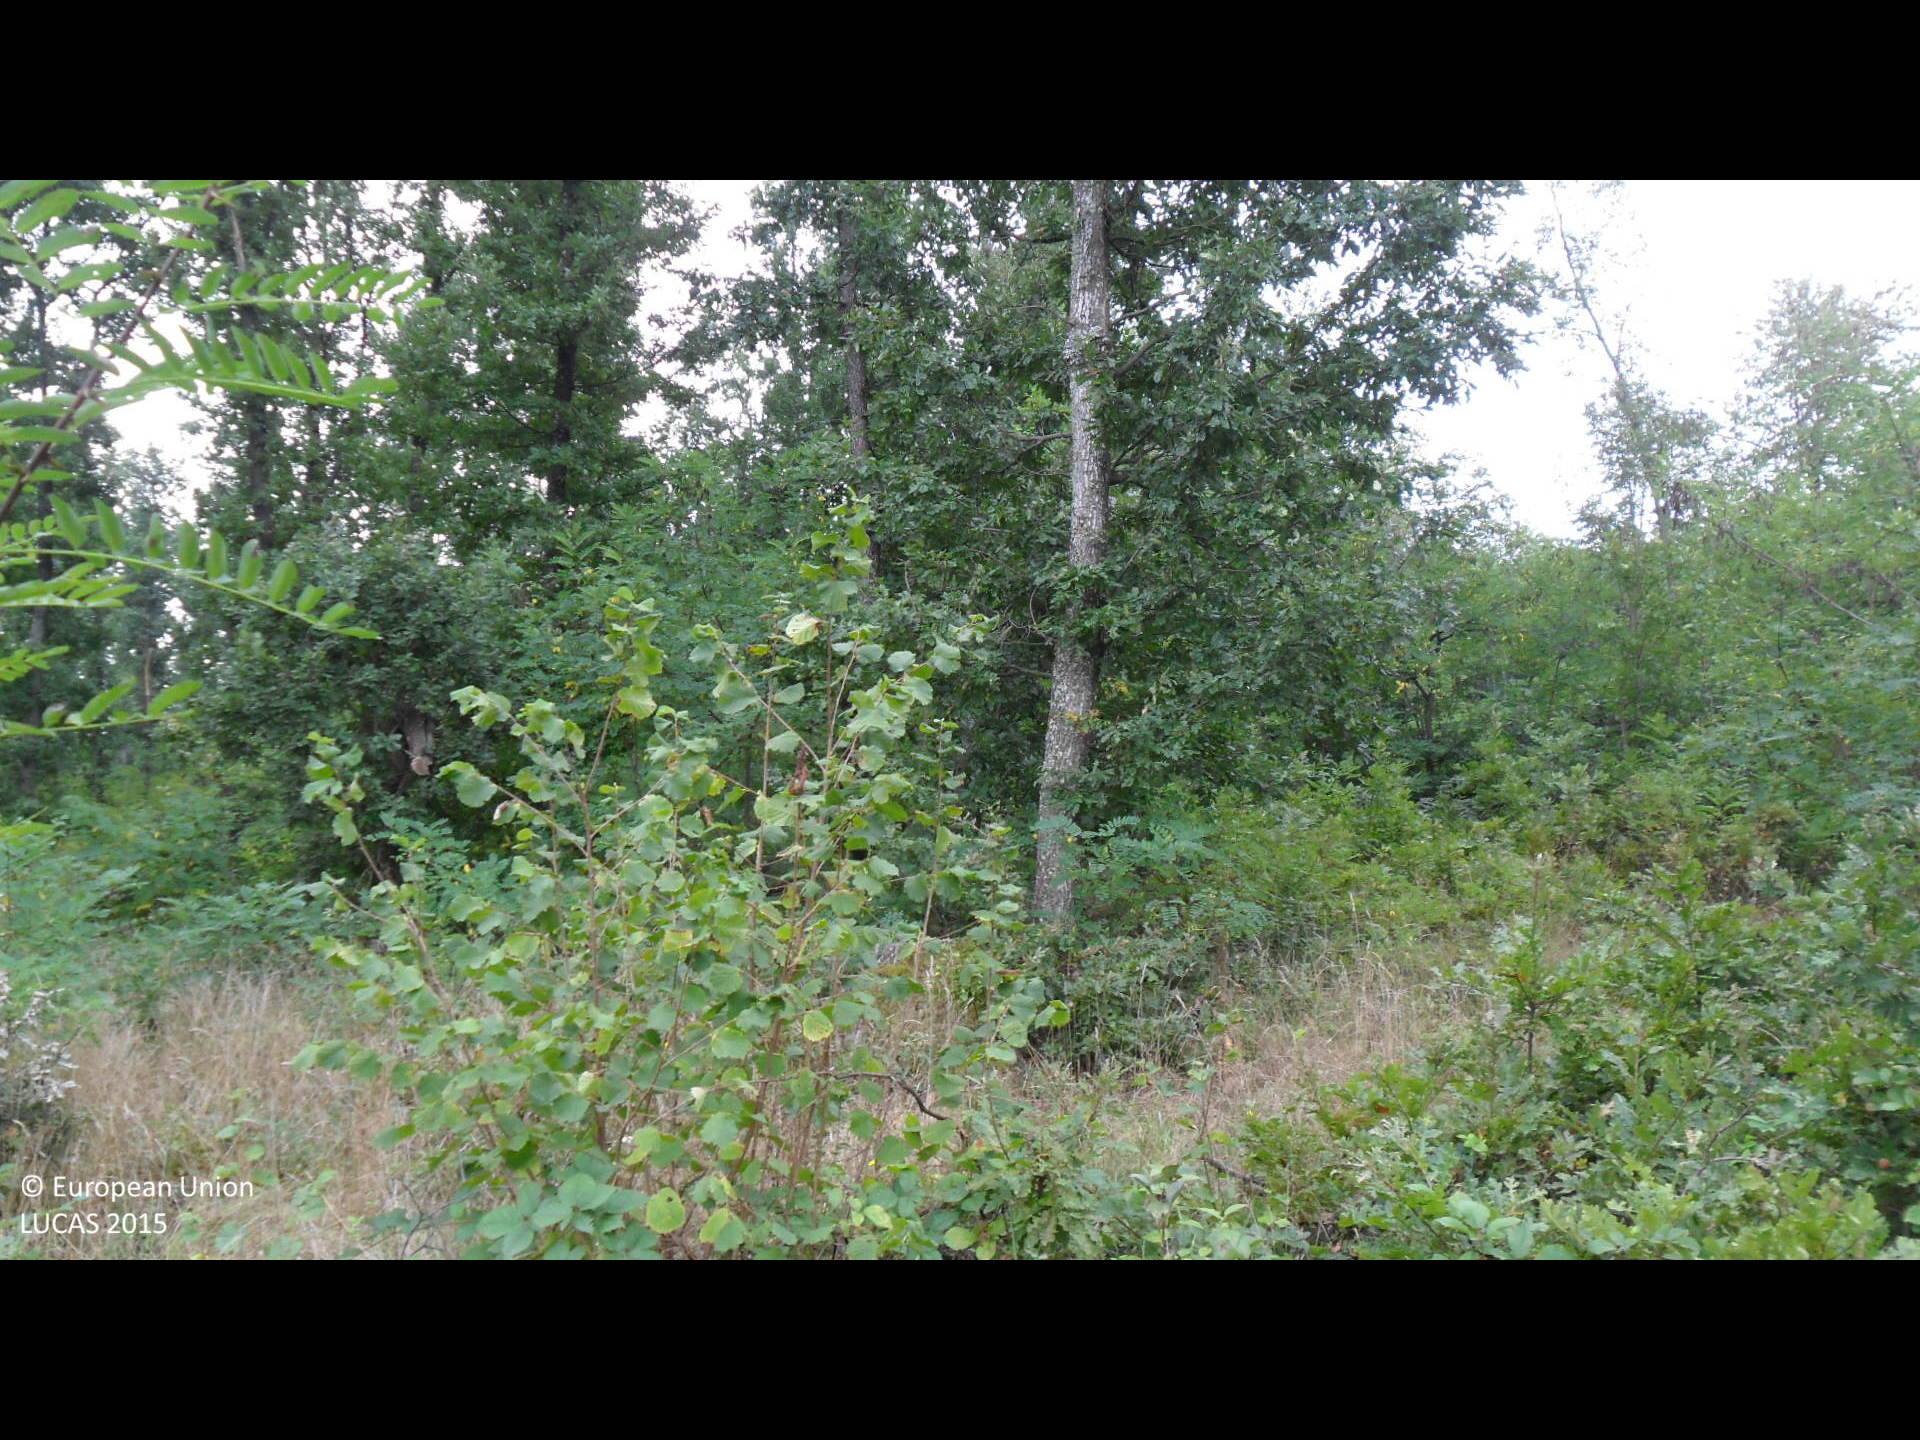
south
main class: Woodland
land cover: Broadleaved woodland
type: mesophytic deciduous forest
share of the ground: > 75 %
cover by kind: broadleaved forest trees 95 %, unconsolidated bare surface 5 %
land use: Forestry
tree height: > 5 m
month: September
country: BG
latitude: 43.1136
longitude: 26.2547
